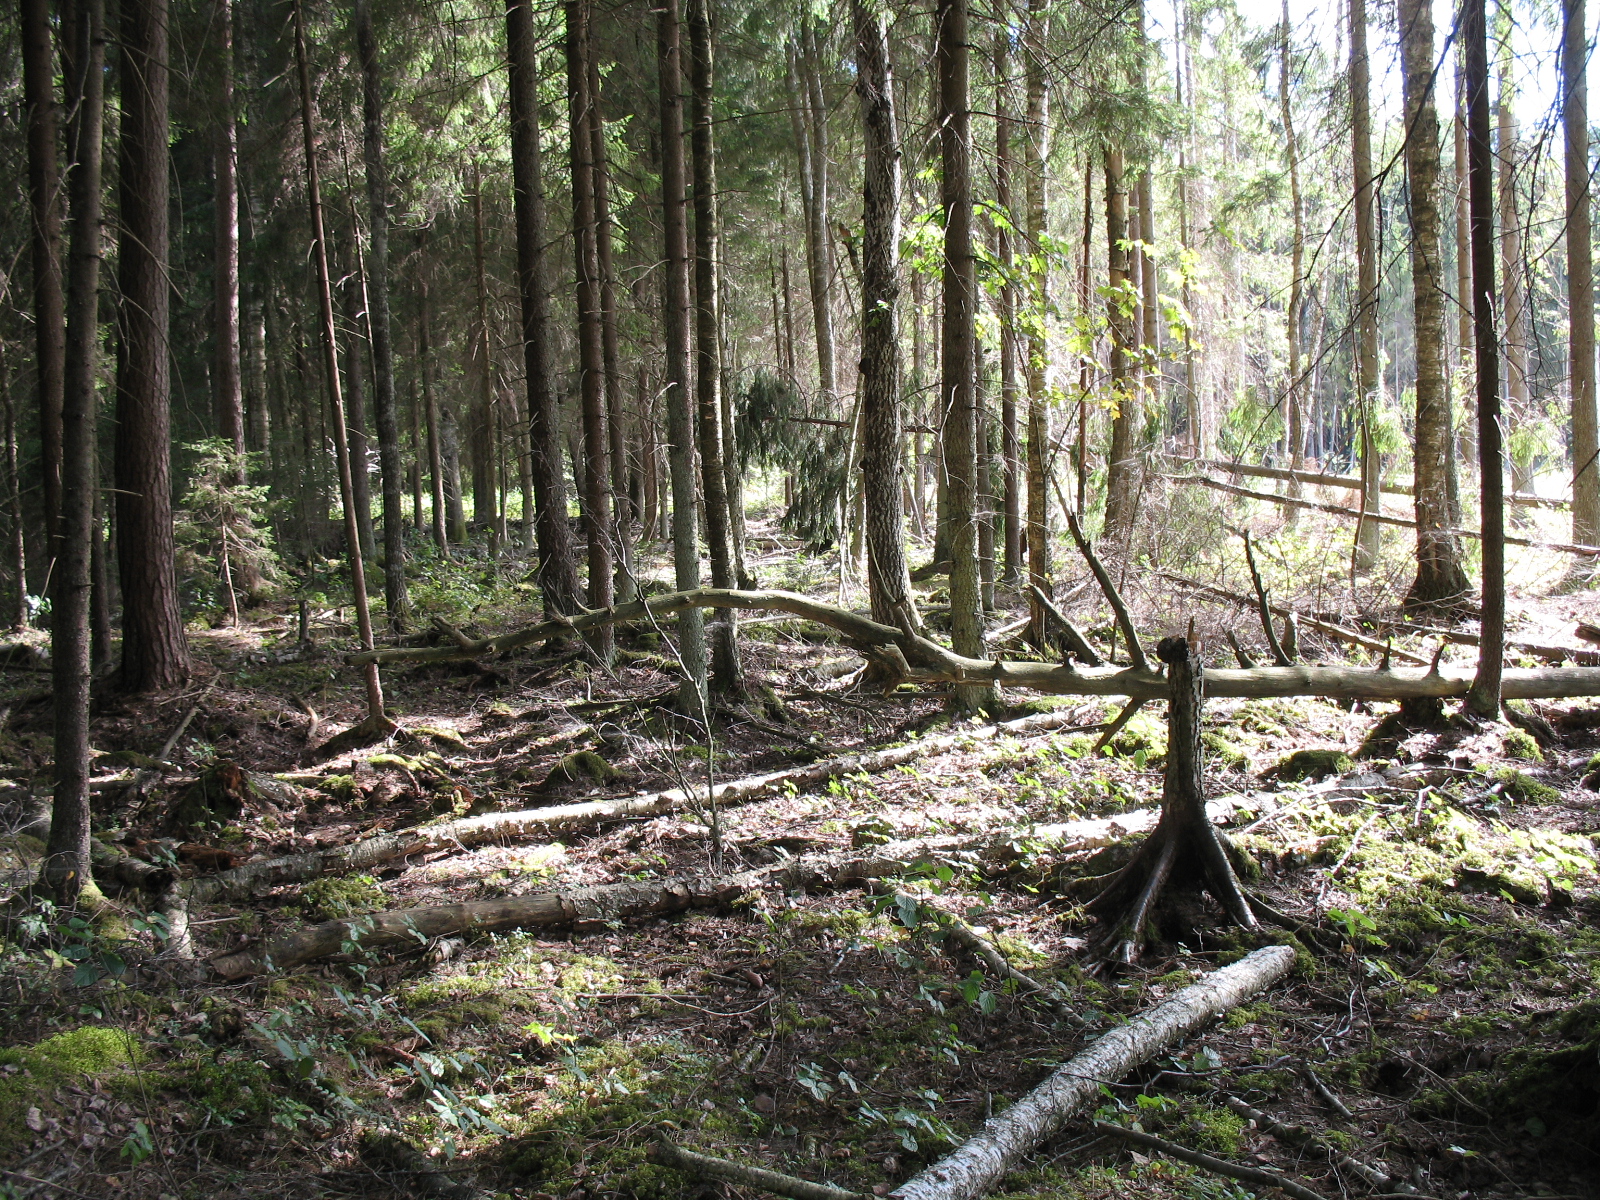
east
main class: Woodland
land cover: Other mixed woodland
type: hemiboreal forest and nemoral coniferous forest and mixed broadleaved-coniferous forest
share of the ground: > 75 %
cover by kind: coniferous forest trees 50 %, broadleaved forest trees 30 %, lichens and mosses 15 %, shrubs 5 %
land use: Forestry
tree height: > 5 m
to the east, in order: Other mixed woodland; Spontaneously vegetated surfaces; Ditches and canals; Other mixed woodland; Other coniferous woodland; Spontaneously vegetated surfaces; Abandoned hedges; Ditches and canals; Other mixed woodland; Other coniferous woodland
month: August
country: LV
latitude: 56.4488
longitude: 25.6502
